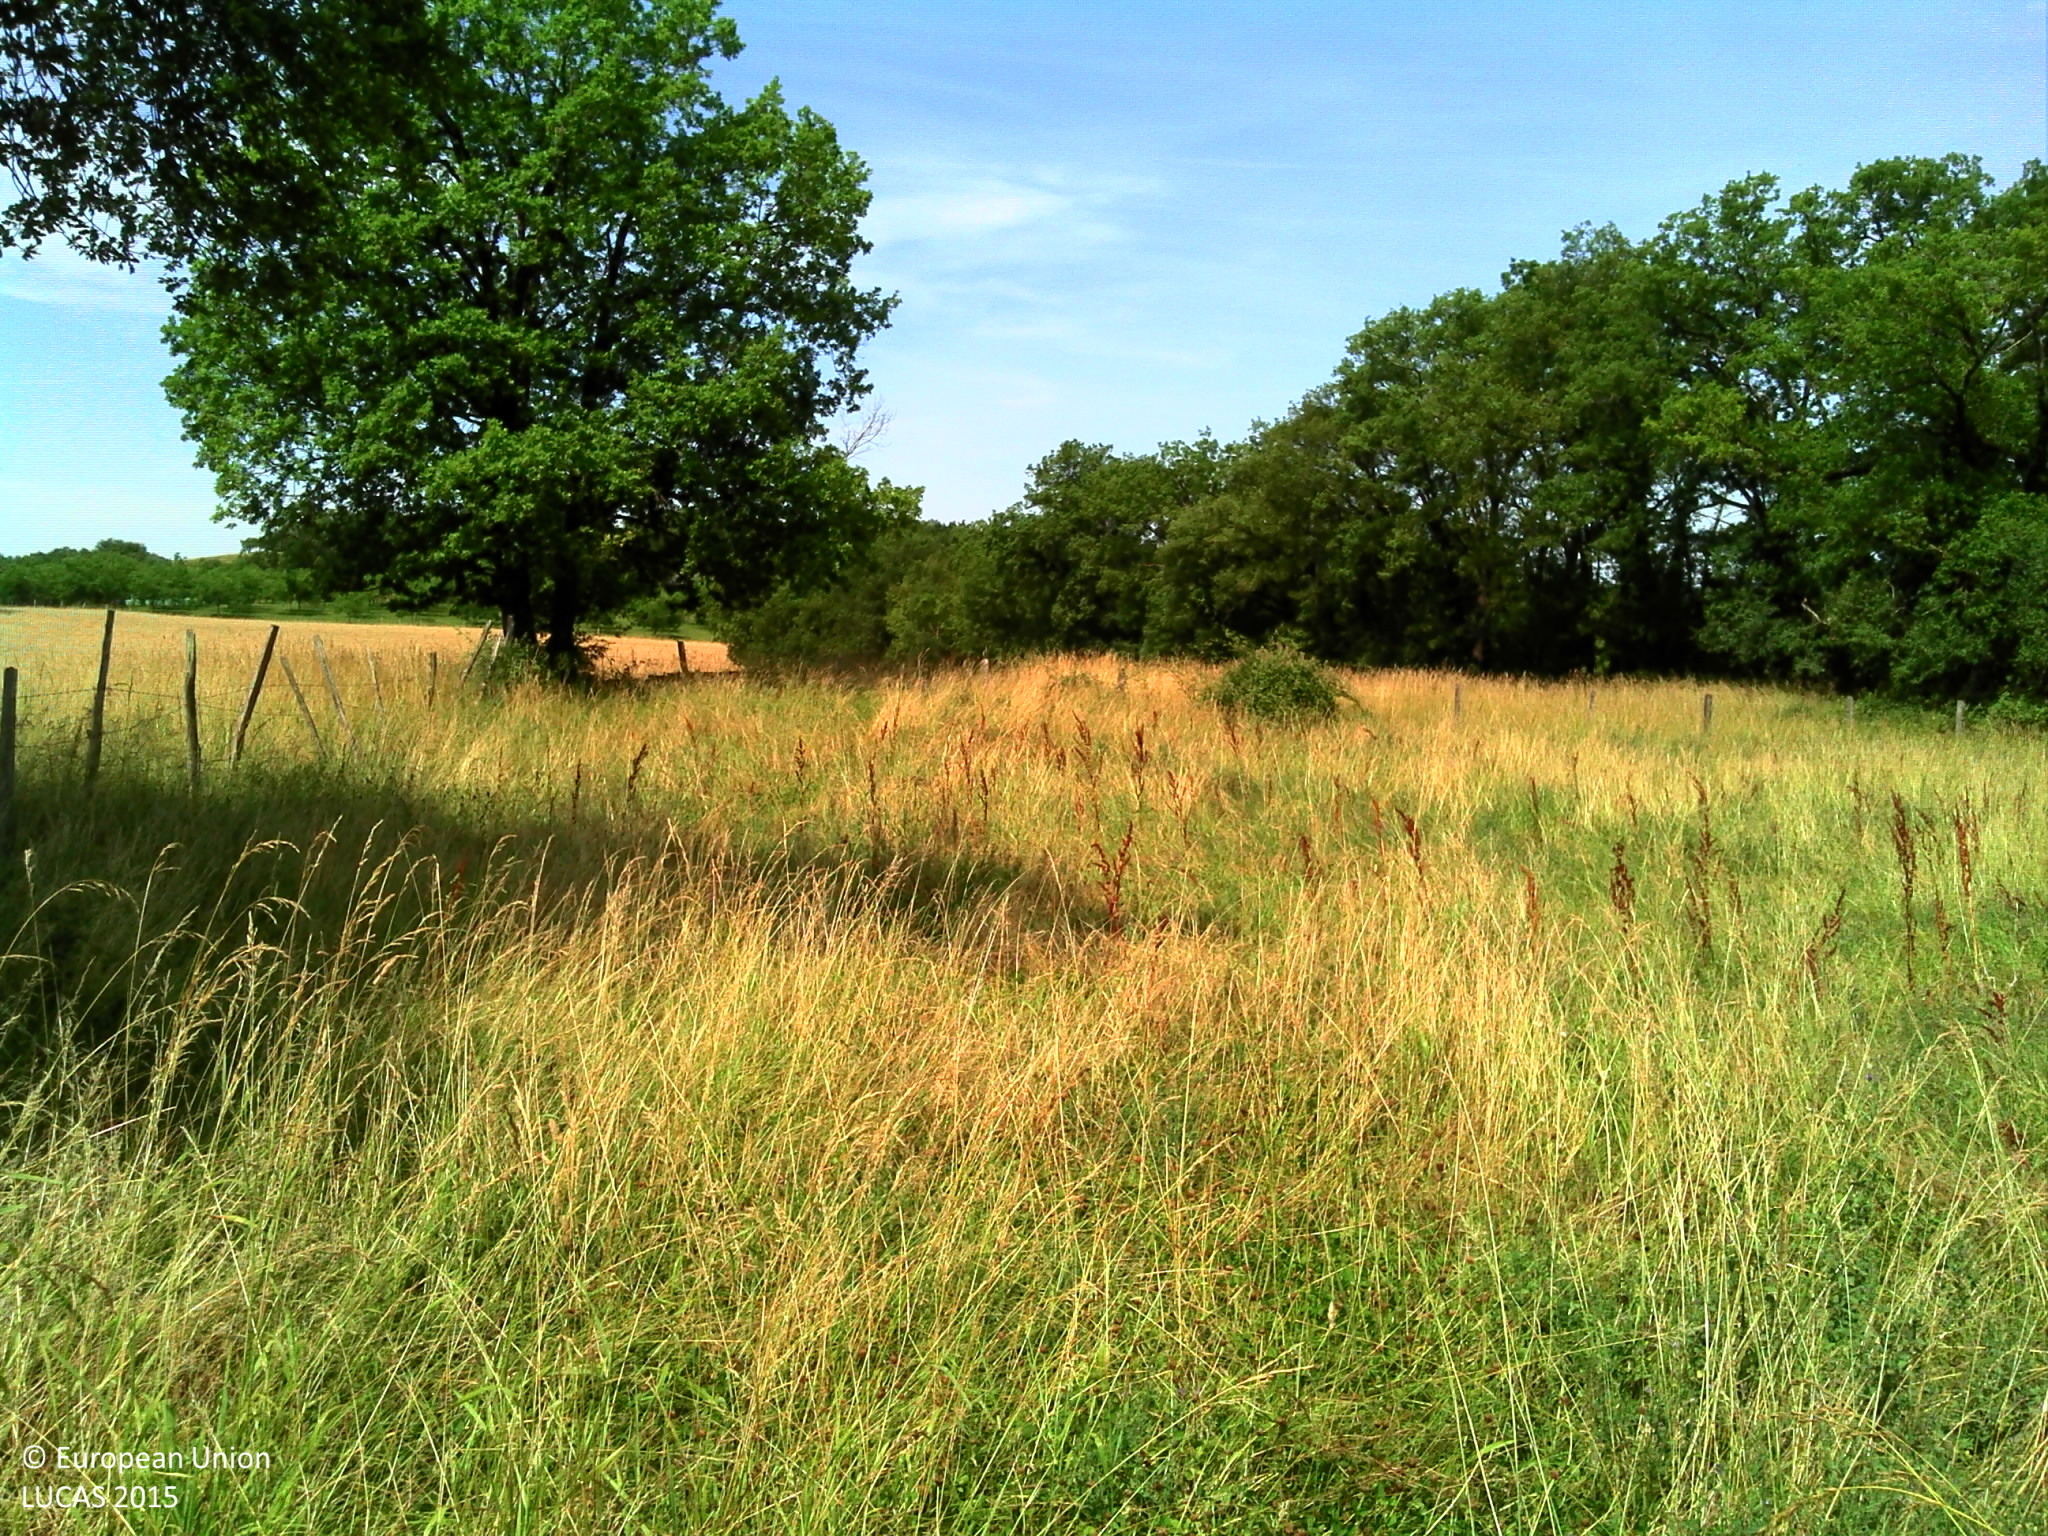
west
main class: Grassland
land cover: Grassland with sparse tree/shrub cover
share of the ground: > 75 %
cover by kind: herbaceous plants 95 %, broadleaved forest trees 5 %
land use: Agriculture (excluding fallow land and kitchen gardens)
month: June
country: FR
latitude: 44.5312
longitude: 2.0098
